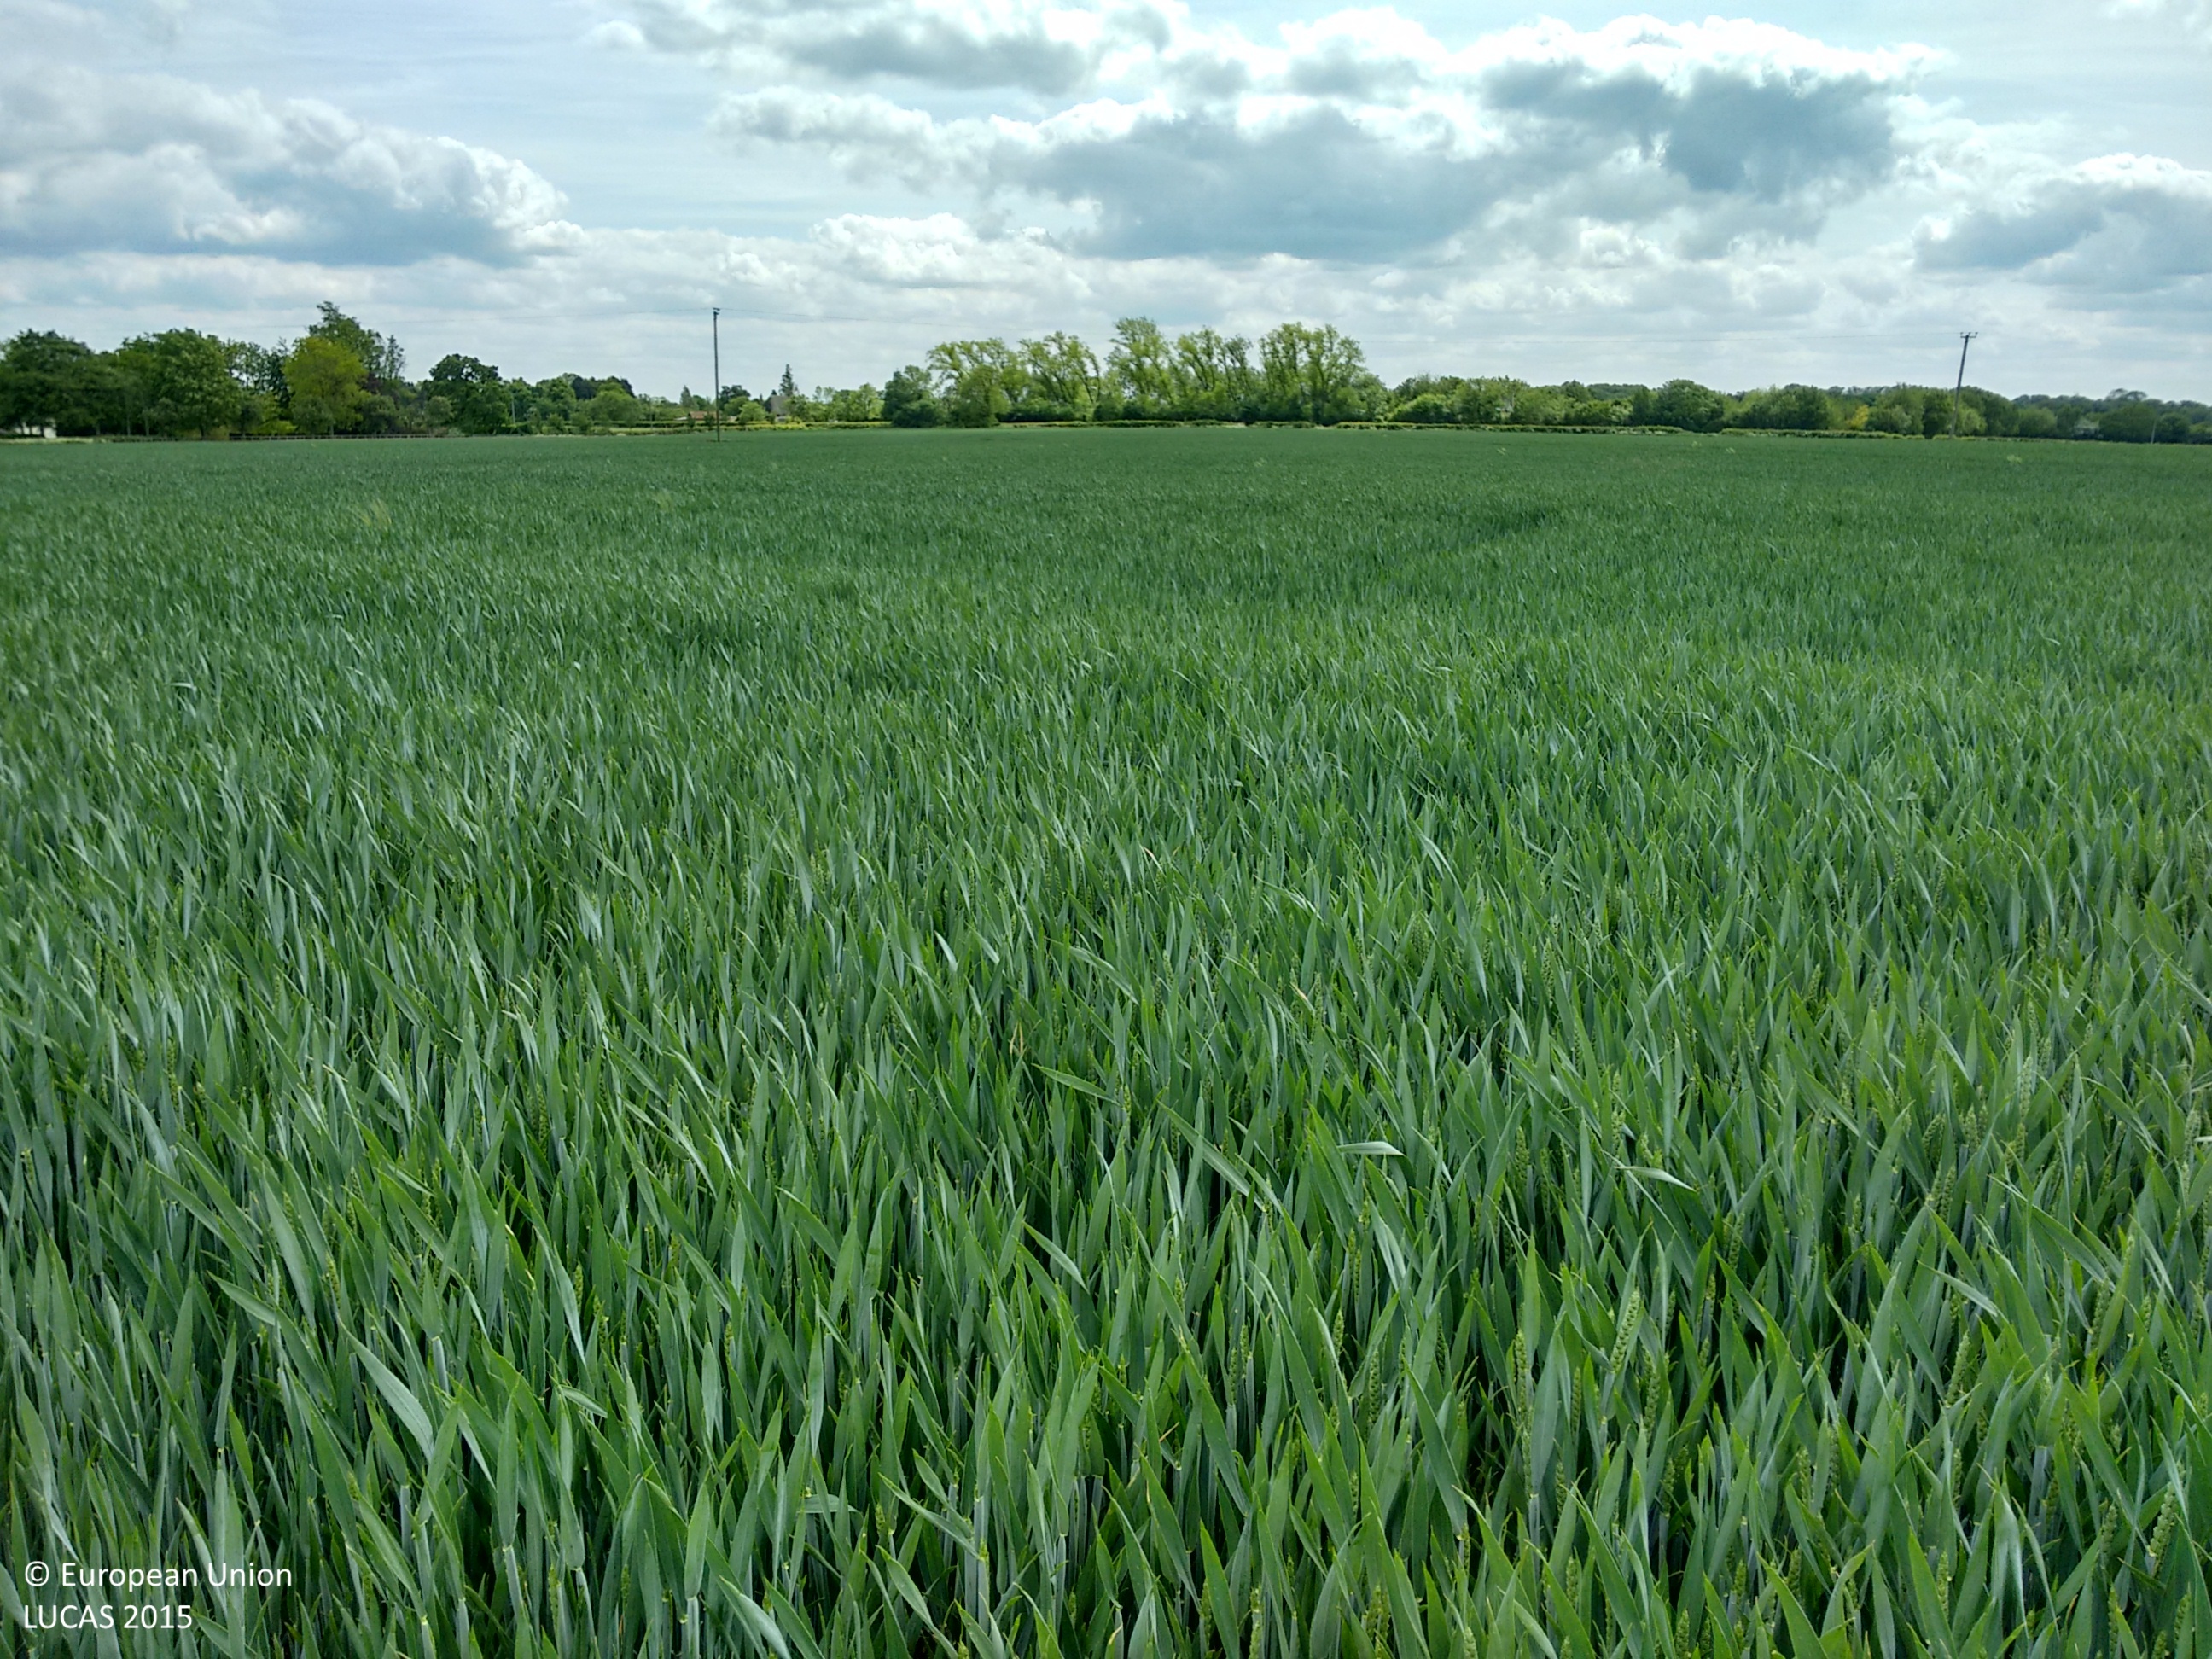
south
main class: Cropland
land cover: Common wheat
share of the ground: > 75 %
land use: Agriculture (excluding fallow land and kitchen gardens)
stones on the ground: < 10 %
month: May
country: GB
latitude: 51.8499
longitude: 0.0525
